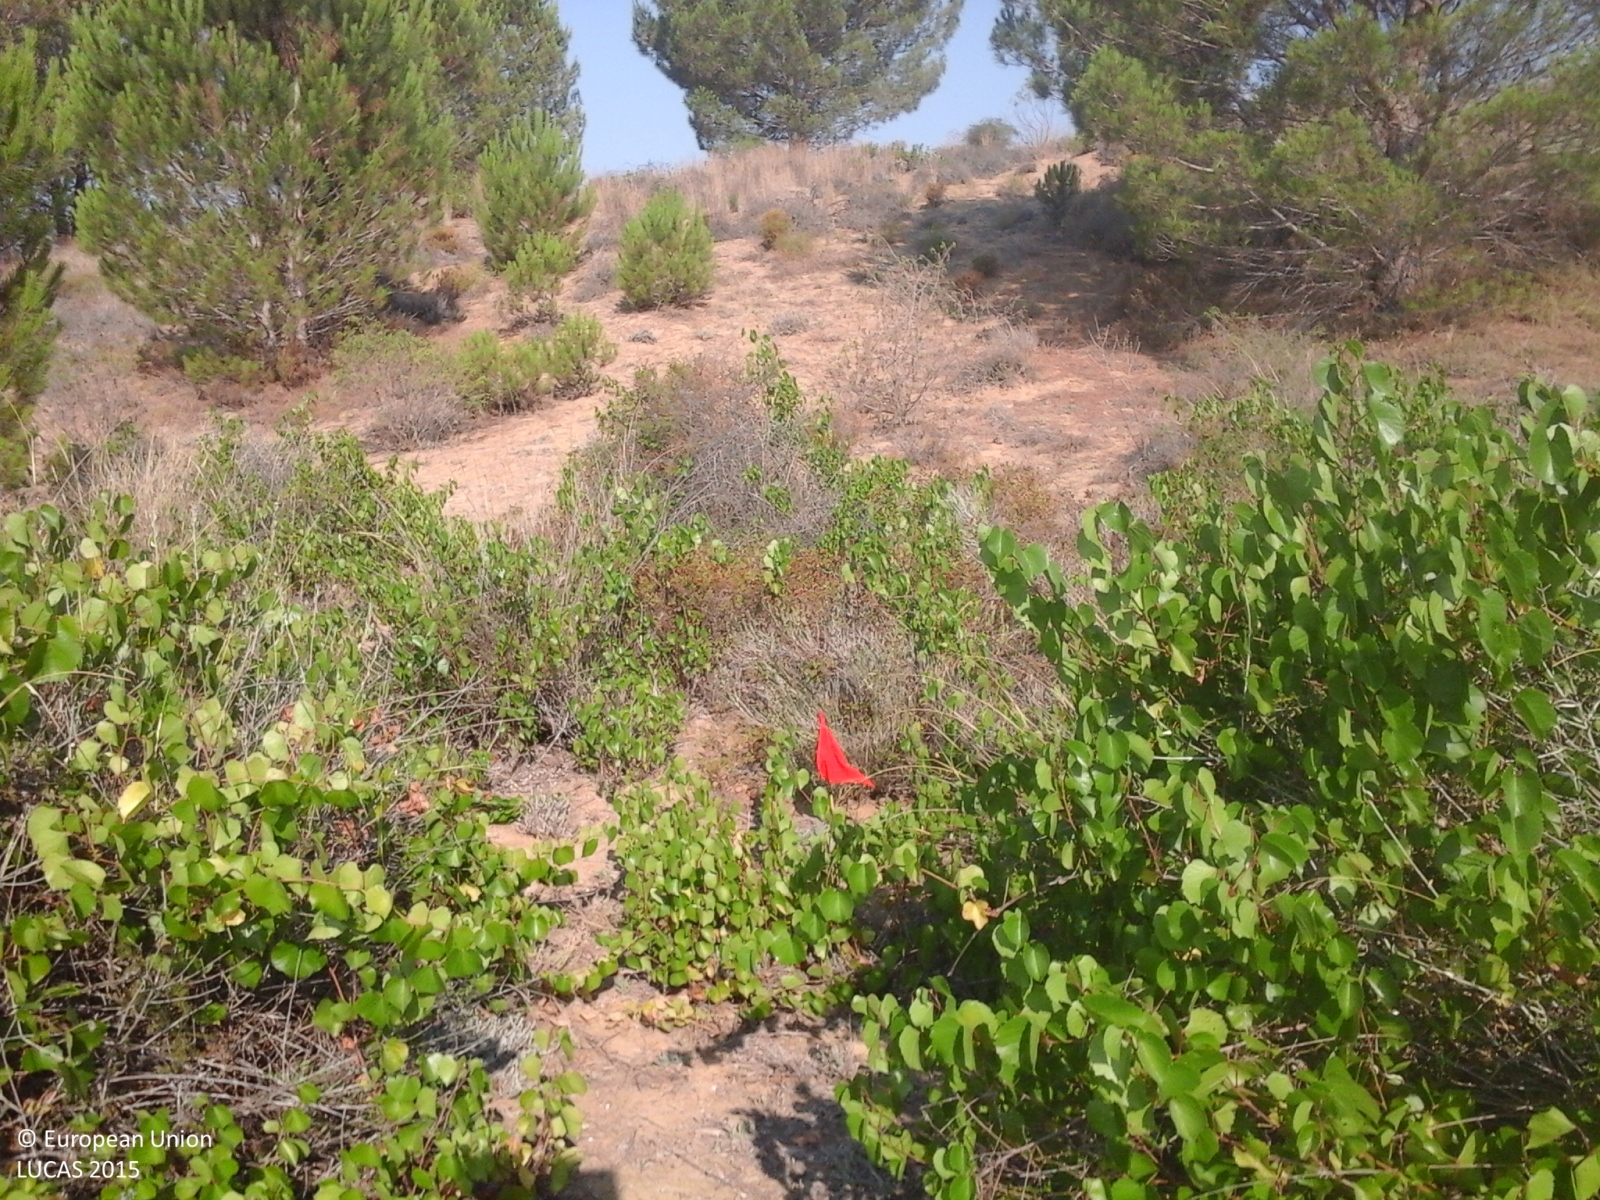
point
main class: Shrubland
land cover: Shrubland with sparse tree cover
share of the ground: > 75 %
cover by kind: shrubs 70 %, herbaceous plants 25 %, coniferous forest trees 5 %
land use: Semi-natural and natural areas not in use
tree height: < 5 m
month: July
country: IT
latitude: 37.0997
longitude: 14.4099
